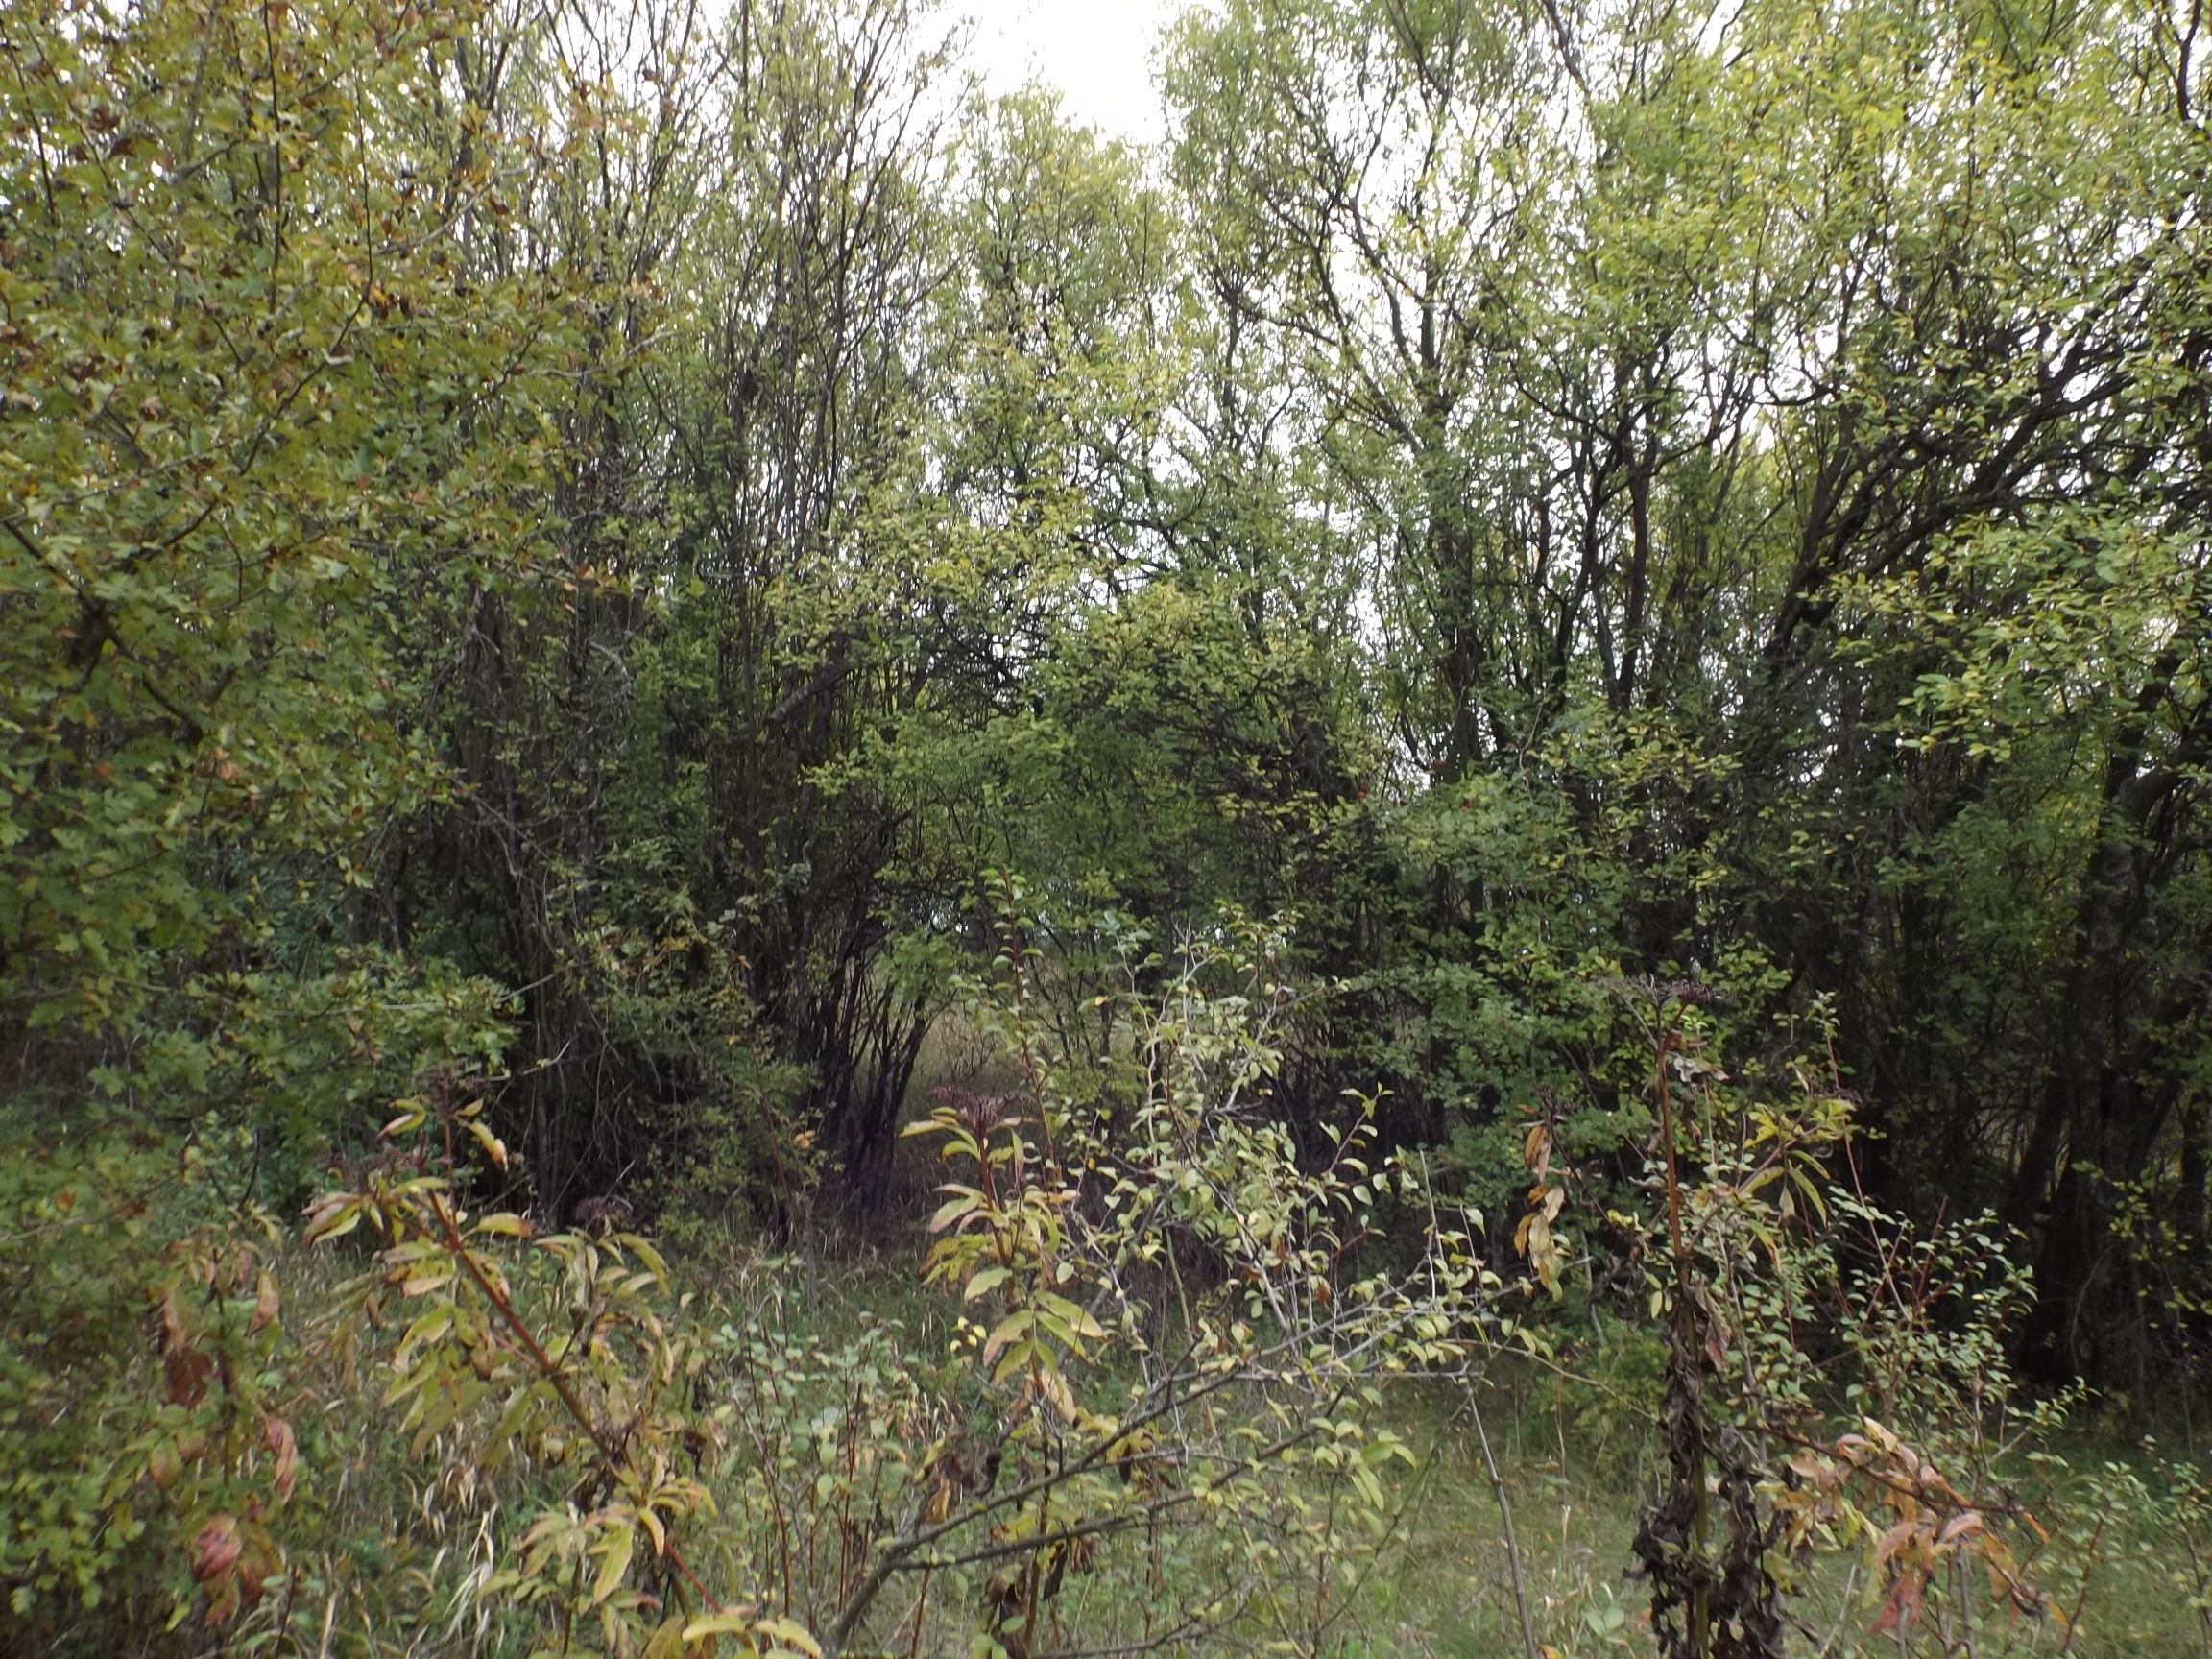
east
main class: Shrubland
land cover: Shrubland with sparse tree cover
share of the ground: > 75 %
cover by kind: shrubs 65 %, herbaceous plants 30 %, broadleaved forest trees 5 %
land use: Semi-natural and natural areas not in use
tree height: > 5 m
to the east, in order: Shrubland with sparse tree cover; Grass margins; Sunflower
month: October
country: BG
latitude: 44.0313
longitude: 26.8263
